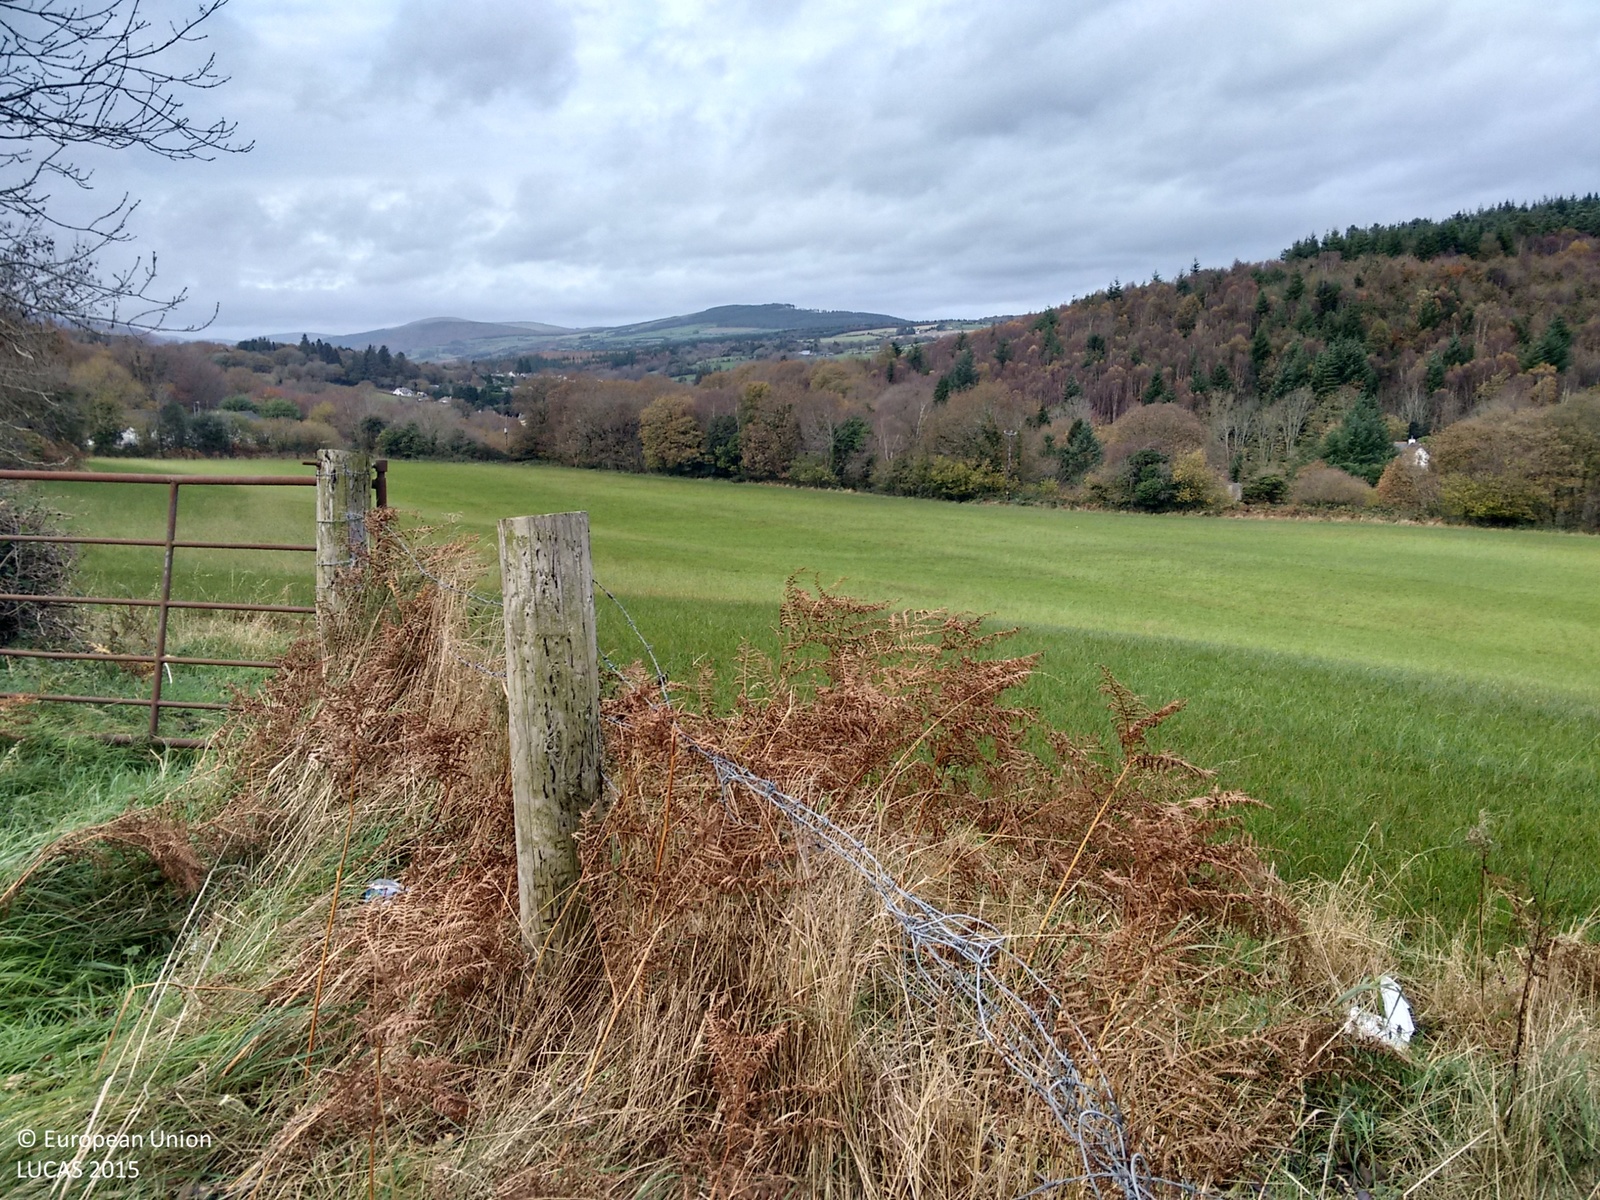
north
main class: Cropland
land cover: Temporary grasslands
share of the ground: > 75 %
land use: Agriculture (excluding fallow land and kitchen gardens)
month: November
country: IE
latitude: 52.8996
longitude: -6.2499
